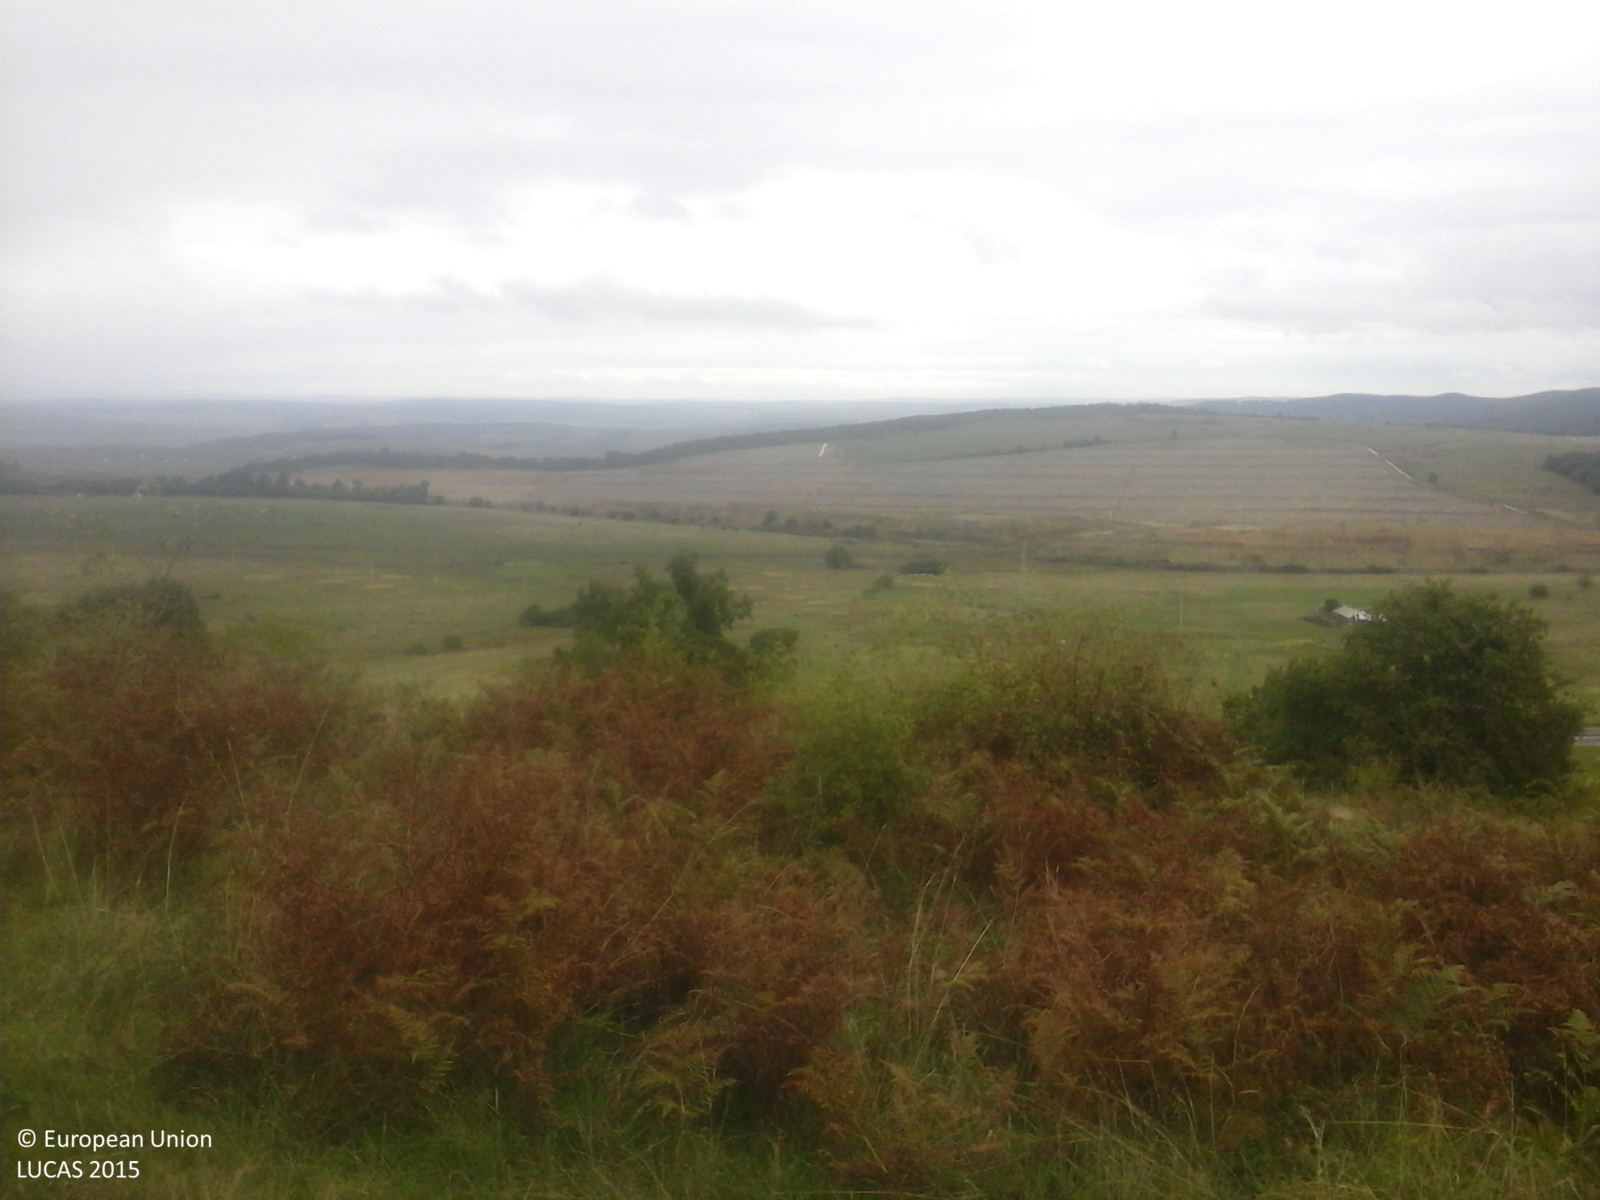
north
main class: Grassland
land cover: Grassland with sparse tree/shrub cover
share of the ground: > 75 %
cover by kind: herbaceous plants 85 %, shrubs 10 %, broadleaved forest trees 5 %
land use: Fallow land
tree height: < 5 m
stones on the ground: < 10 %
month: September
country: RO
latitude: 45.8067
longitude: 23.8769
